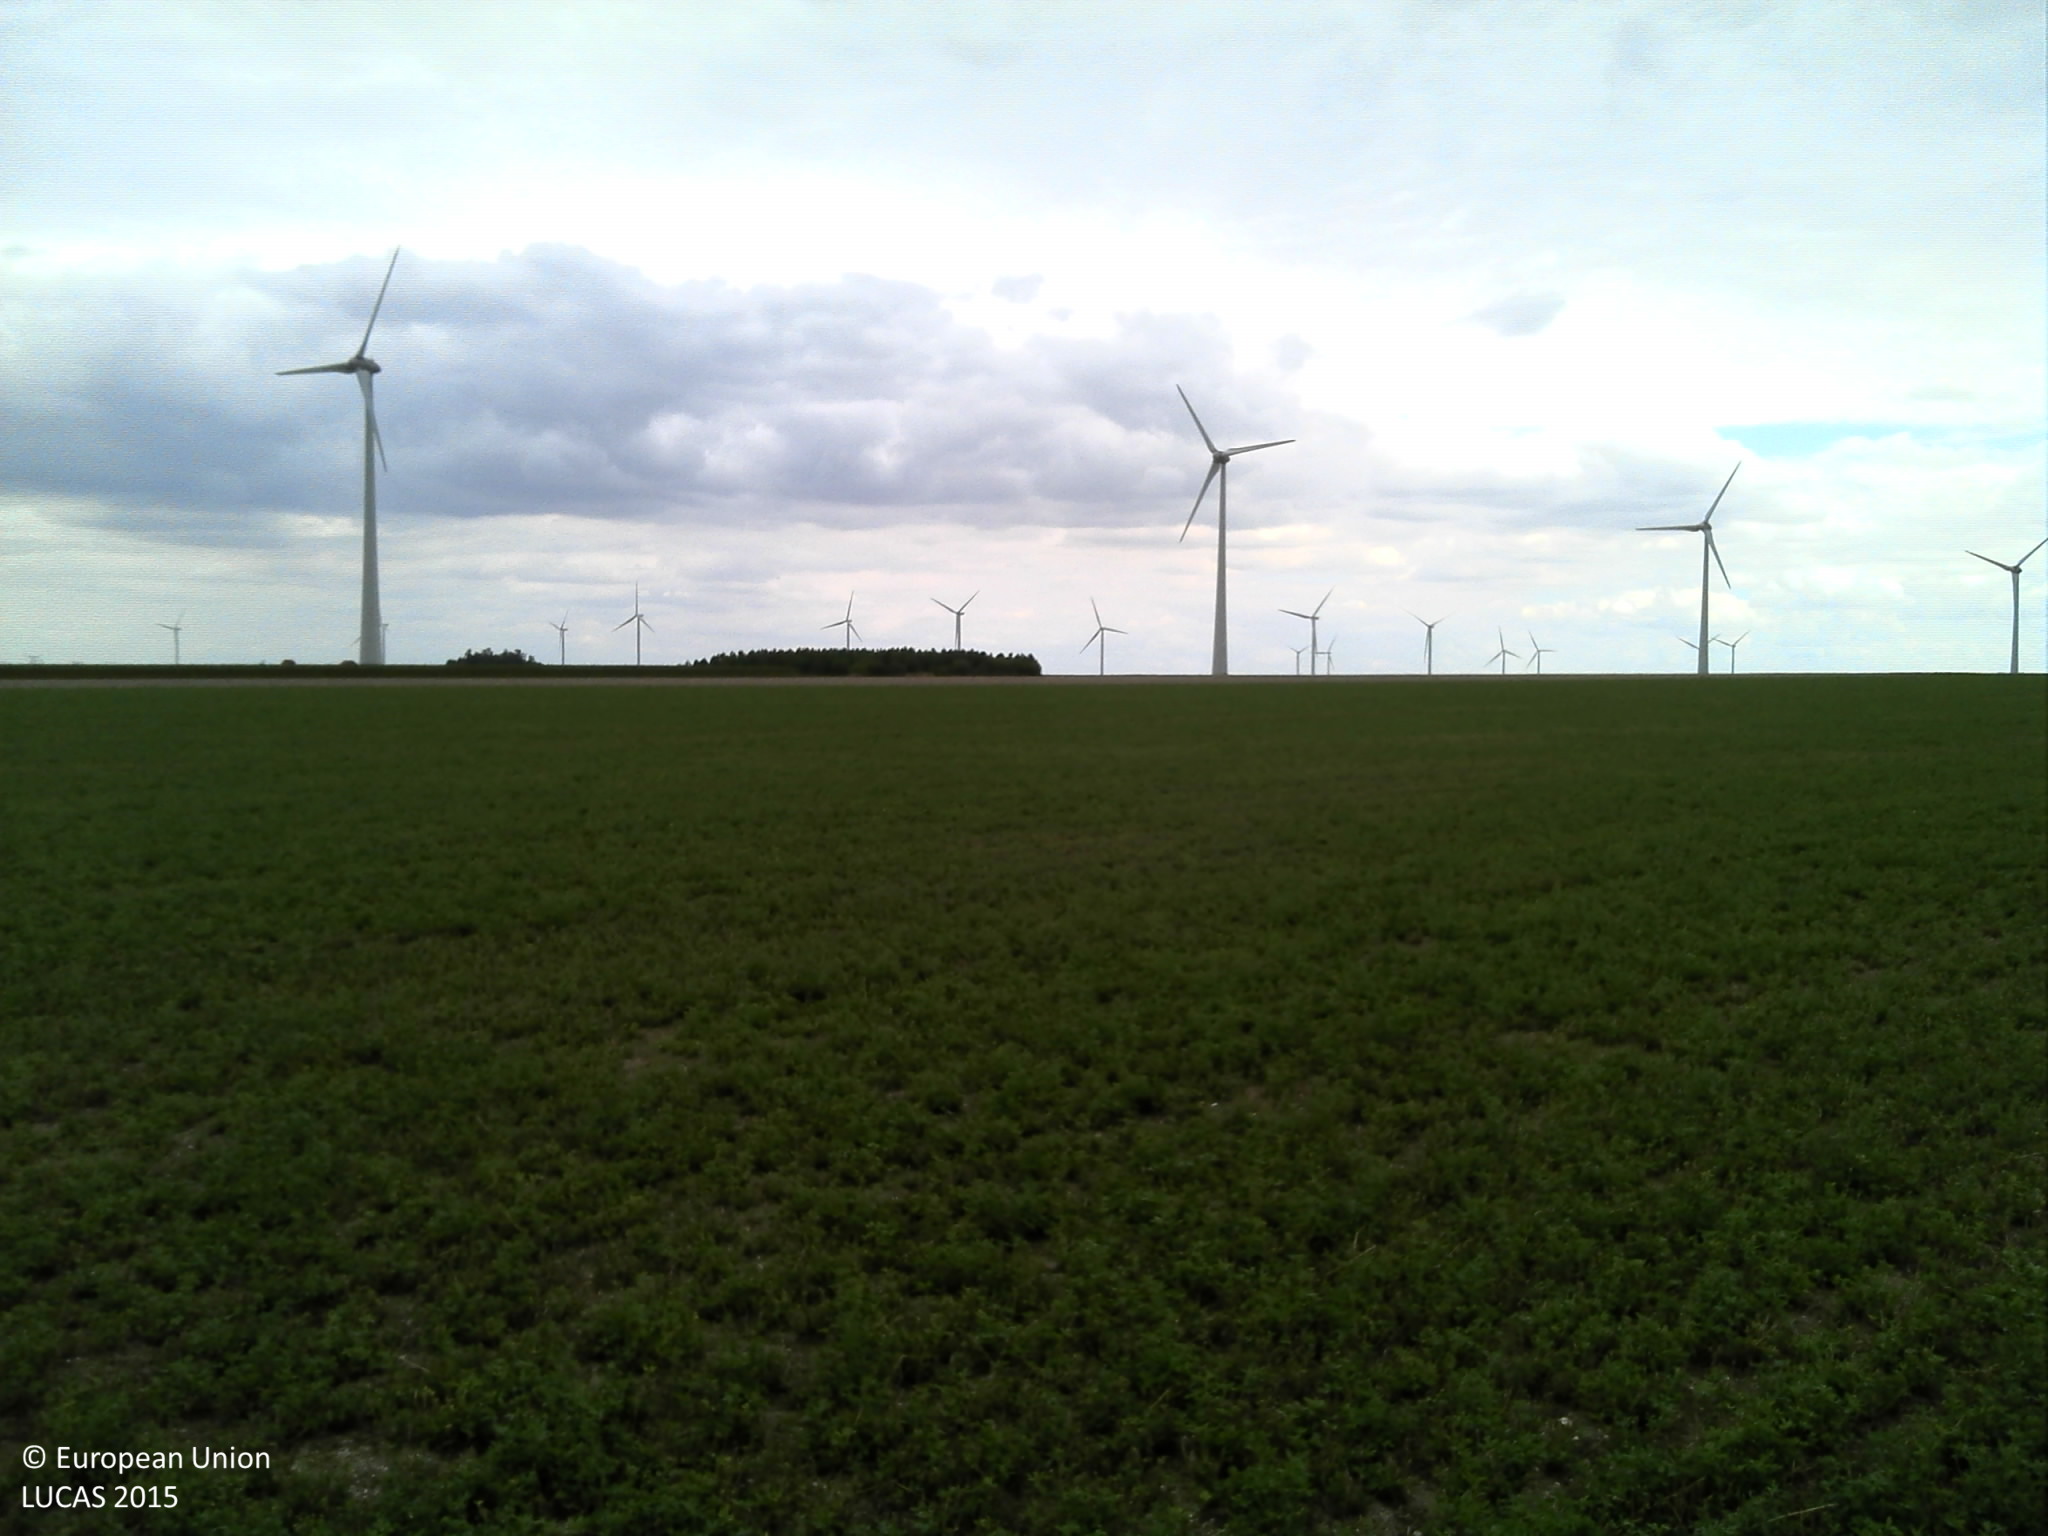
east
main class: Cropland
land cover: Lucerne
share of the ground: 50 - 75 %
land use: Agriculture (excluding fallow land and kitchen gardens)
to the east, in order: Lucerne; Rape and turnip rape
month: August
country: FR
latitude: 48.4649
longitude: 3.8146
